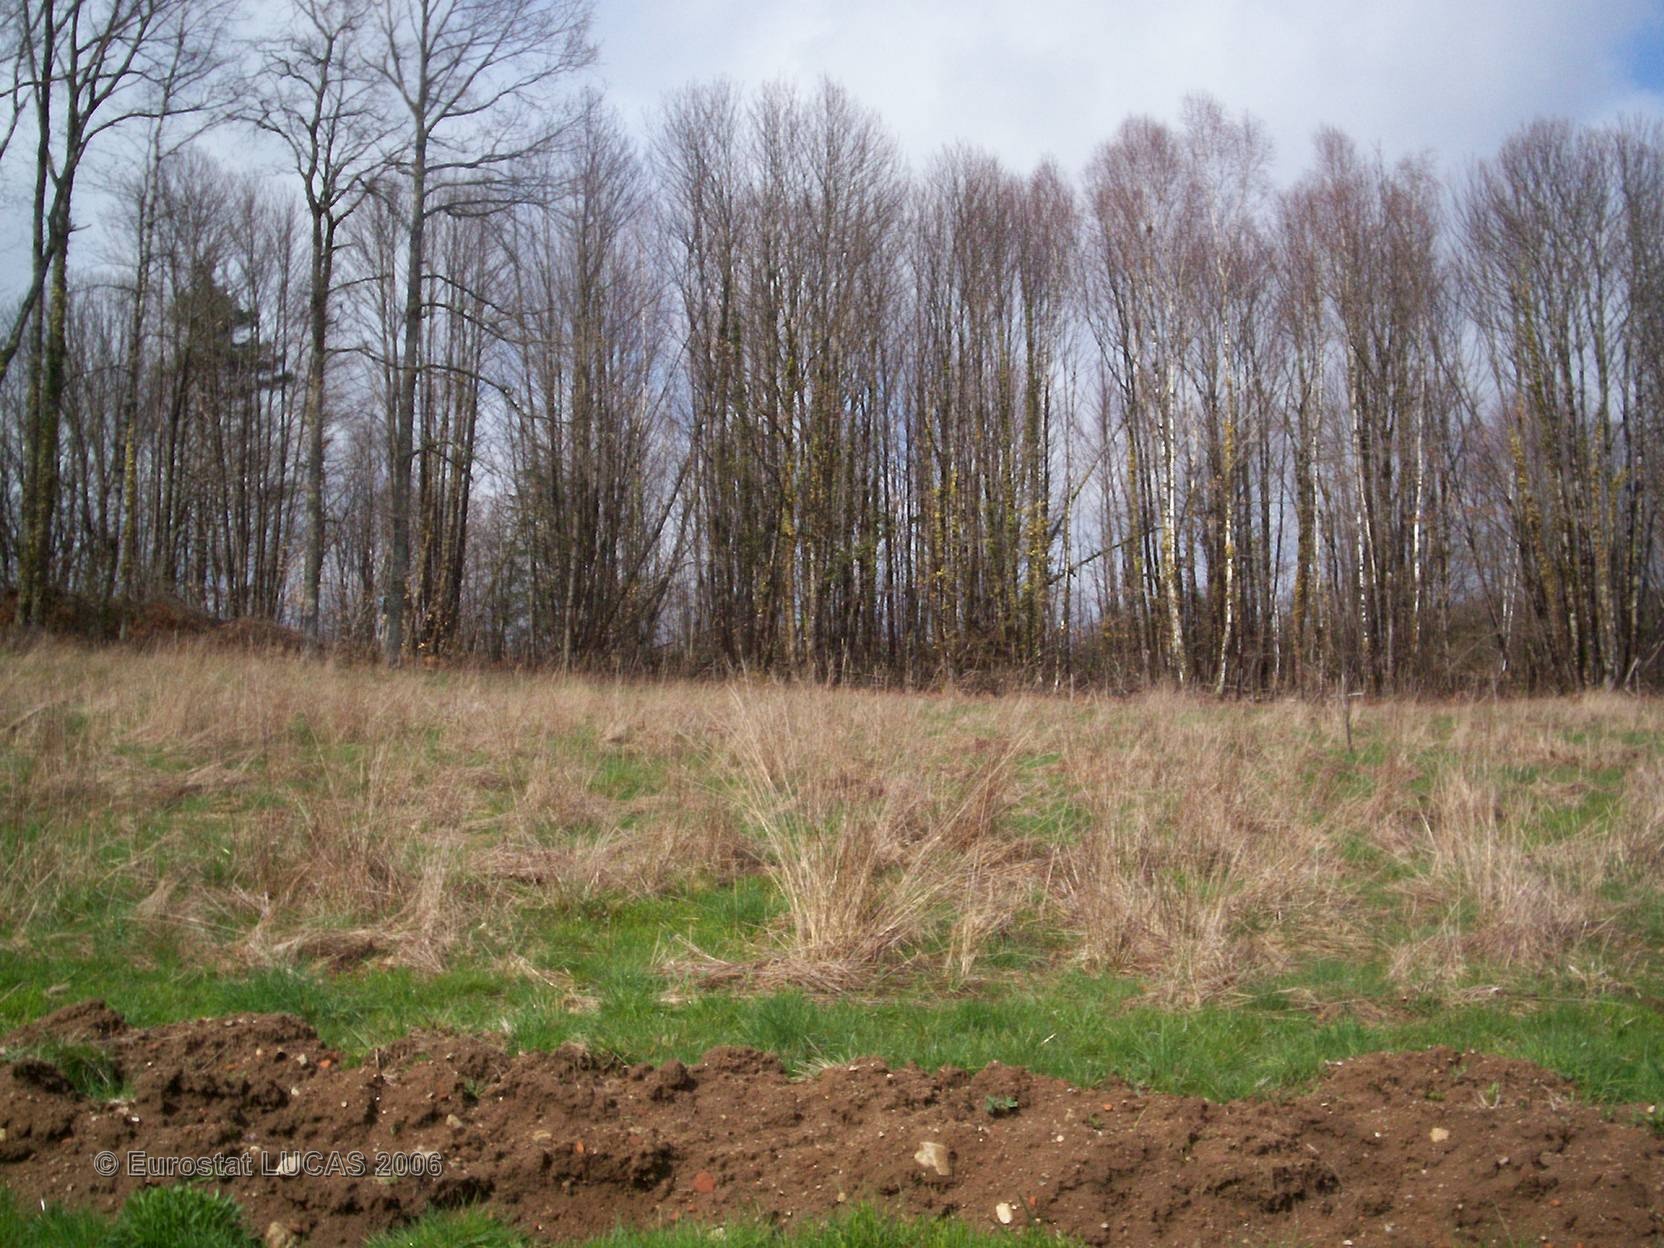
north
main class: Grassland
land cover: Grassland without tree/shrub cover
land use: Agriculture (excluding fallow land and kitchen gardens)
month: April
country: FR
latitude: 45.5479
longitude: 1.5787
